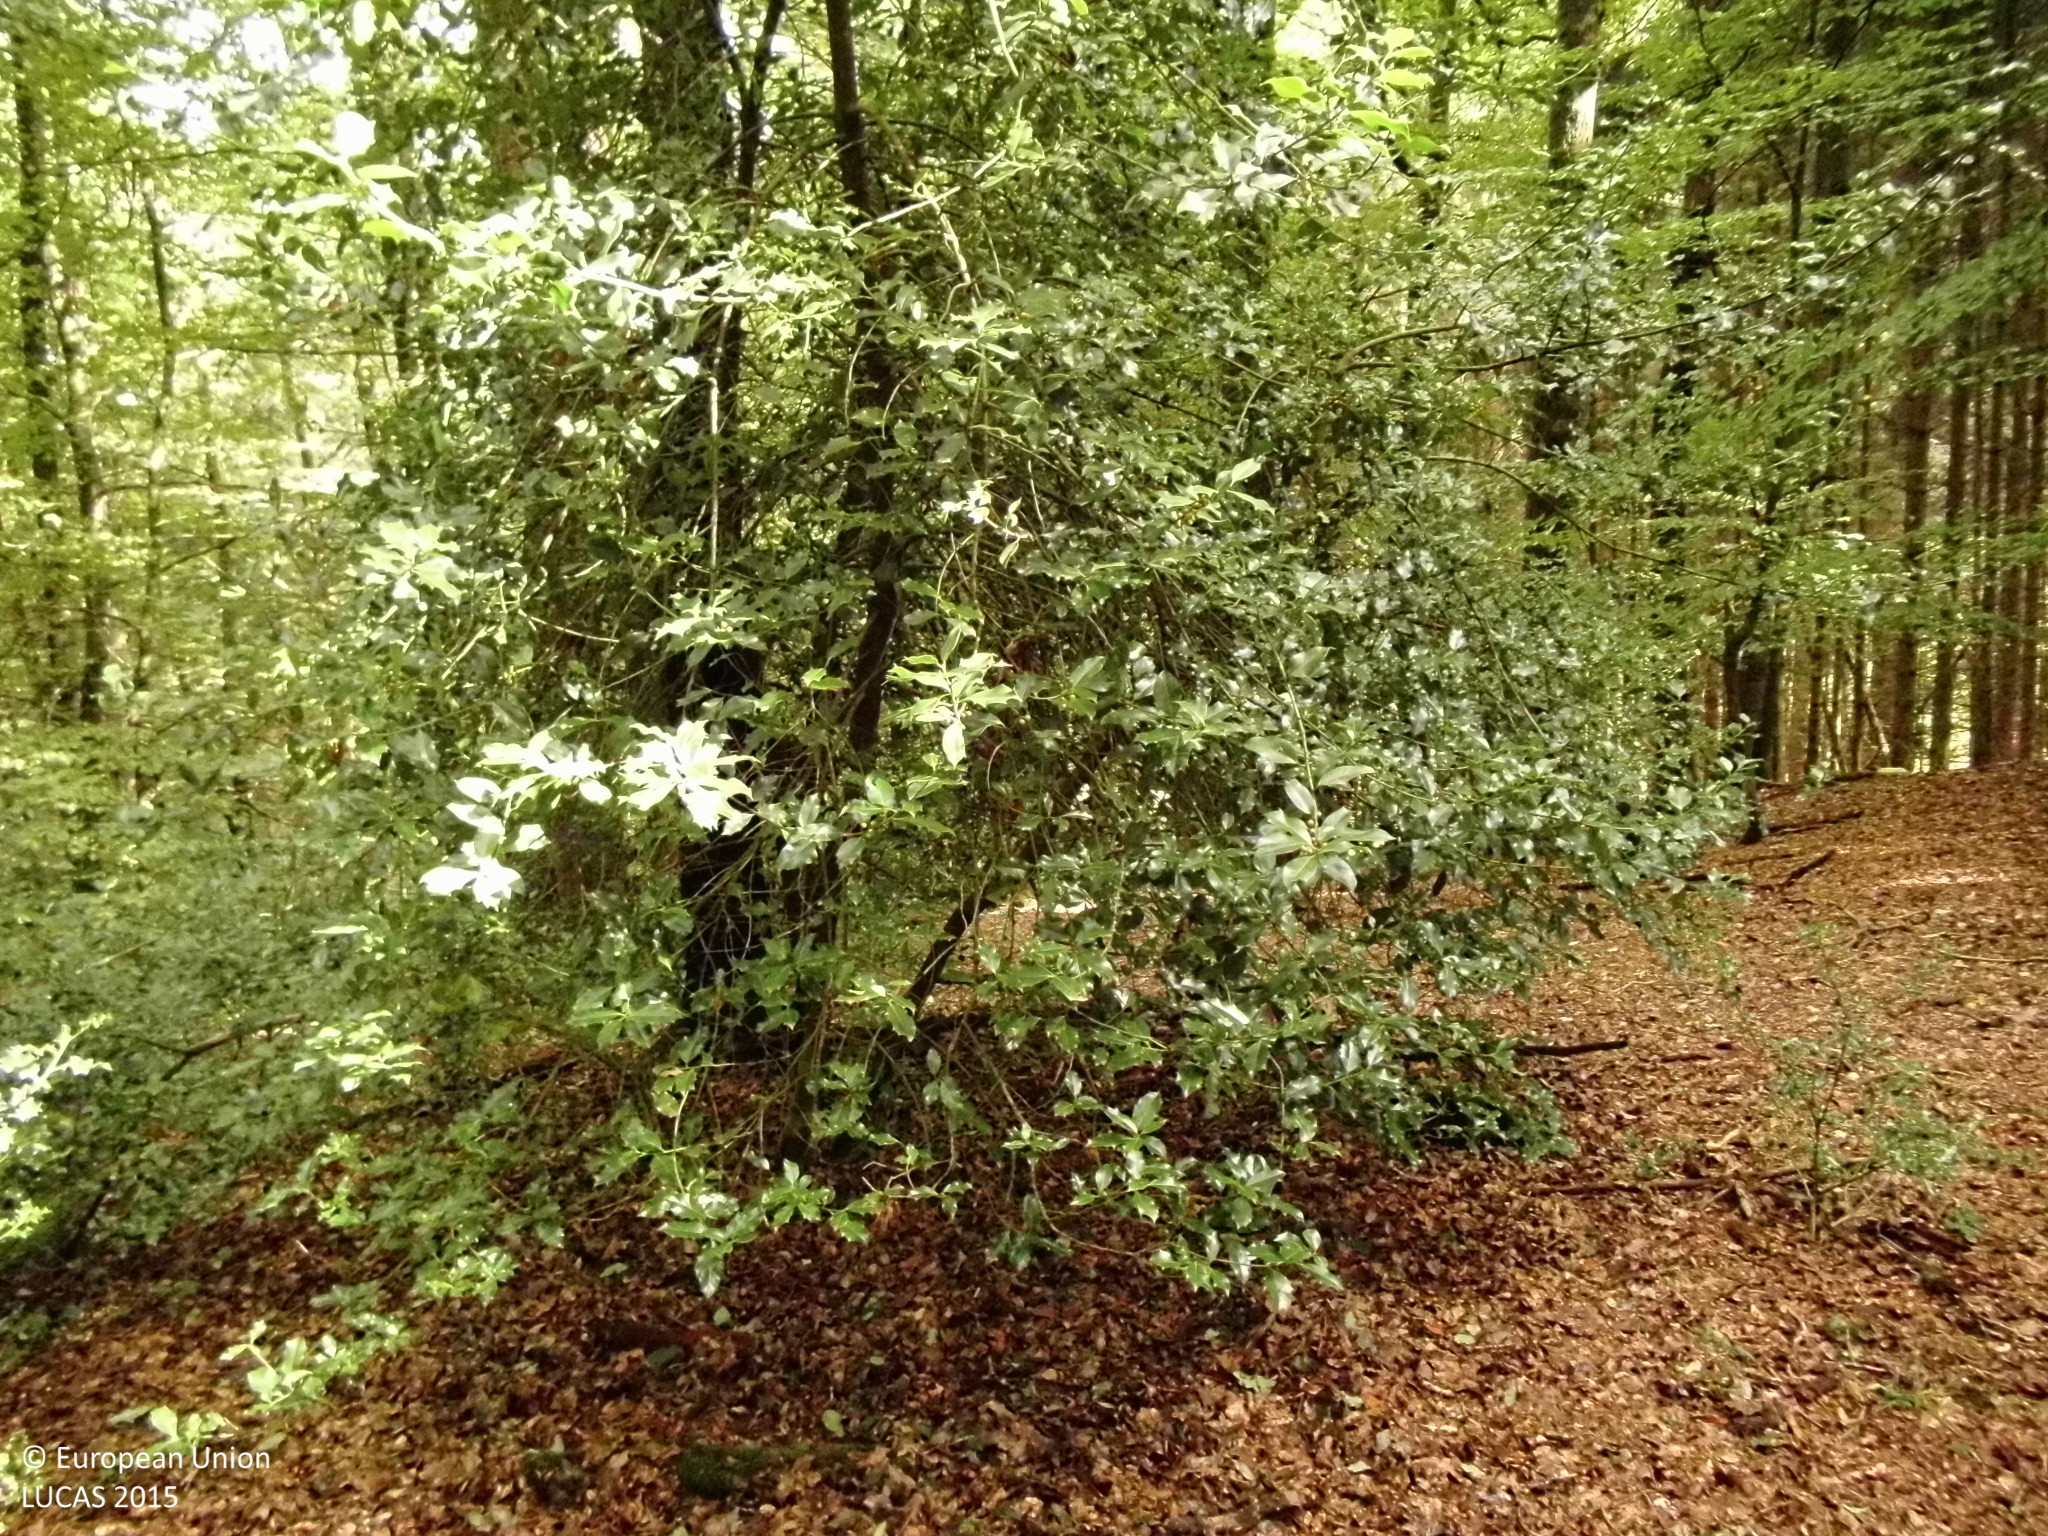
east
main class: Woodland
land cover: Broadleaved woodland
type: mesophytic deciduous forest
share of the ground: > 75 %
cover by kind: broadleaved forest trees 100 %
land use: Forestry
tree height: > 5 m
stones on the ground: < 10 %
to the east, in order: Broadleaved woodland; Spruce dominated coniferous woodland; Fences; Grassland without tree/shrub cover; Broadleaved woodland; Rivers and streams; Grassland without tree/shrub cover; Broadleaved woodland
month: September
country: DE
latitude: 51.0923
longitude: 7.5016
